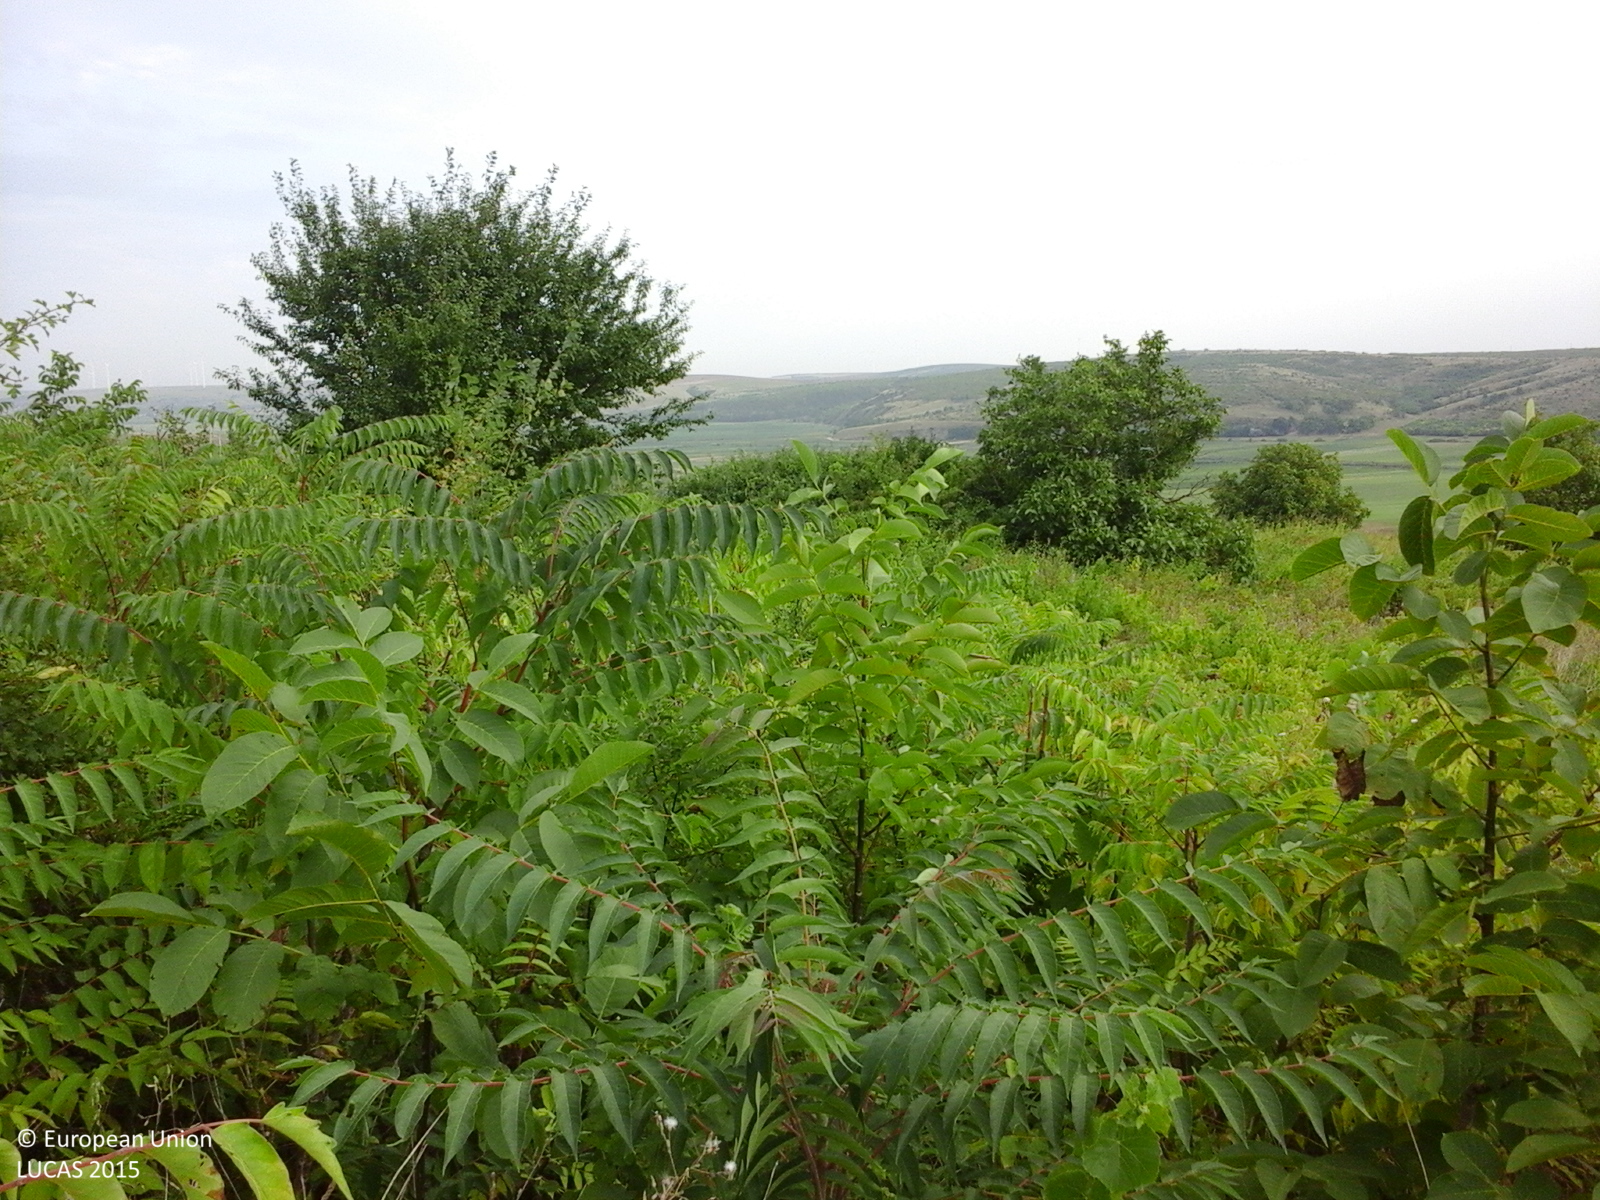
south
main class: Shrubland
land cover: Shrubland with sparse tree cover
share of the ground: > 75 %
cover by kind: shrubs 85 %, herbaceous plants 10 %, broadleaved forest trees 5 %
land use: Semi-natural and natural areas not in use
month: August
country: RO
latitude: 44.2715
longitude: 28.0081
